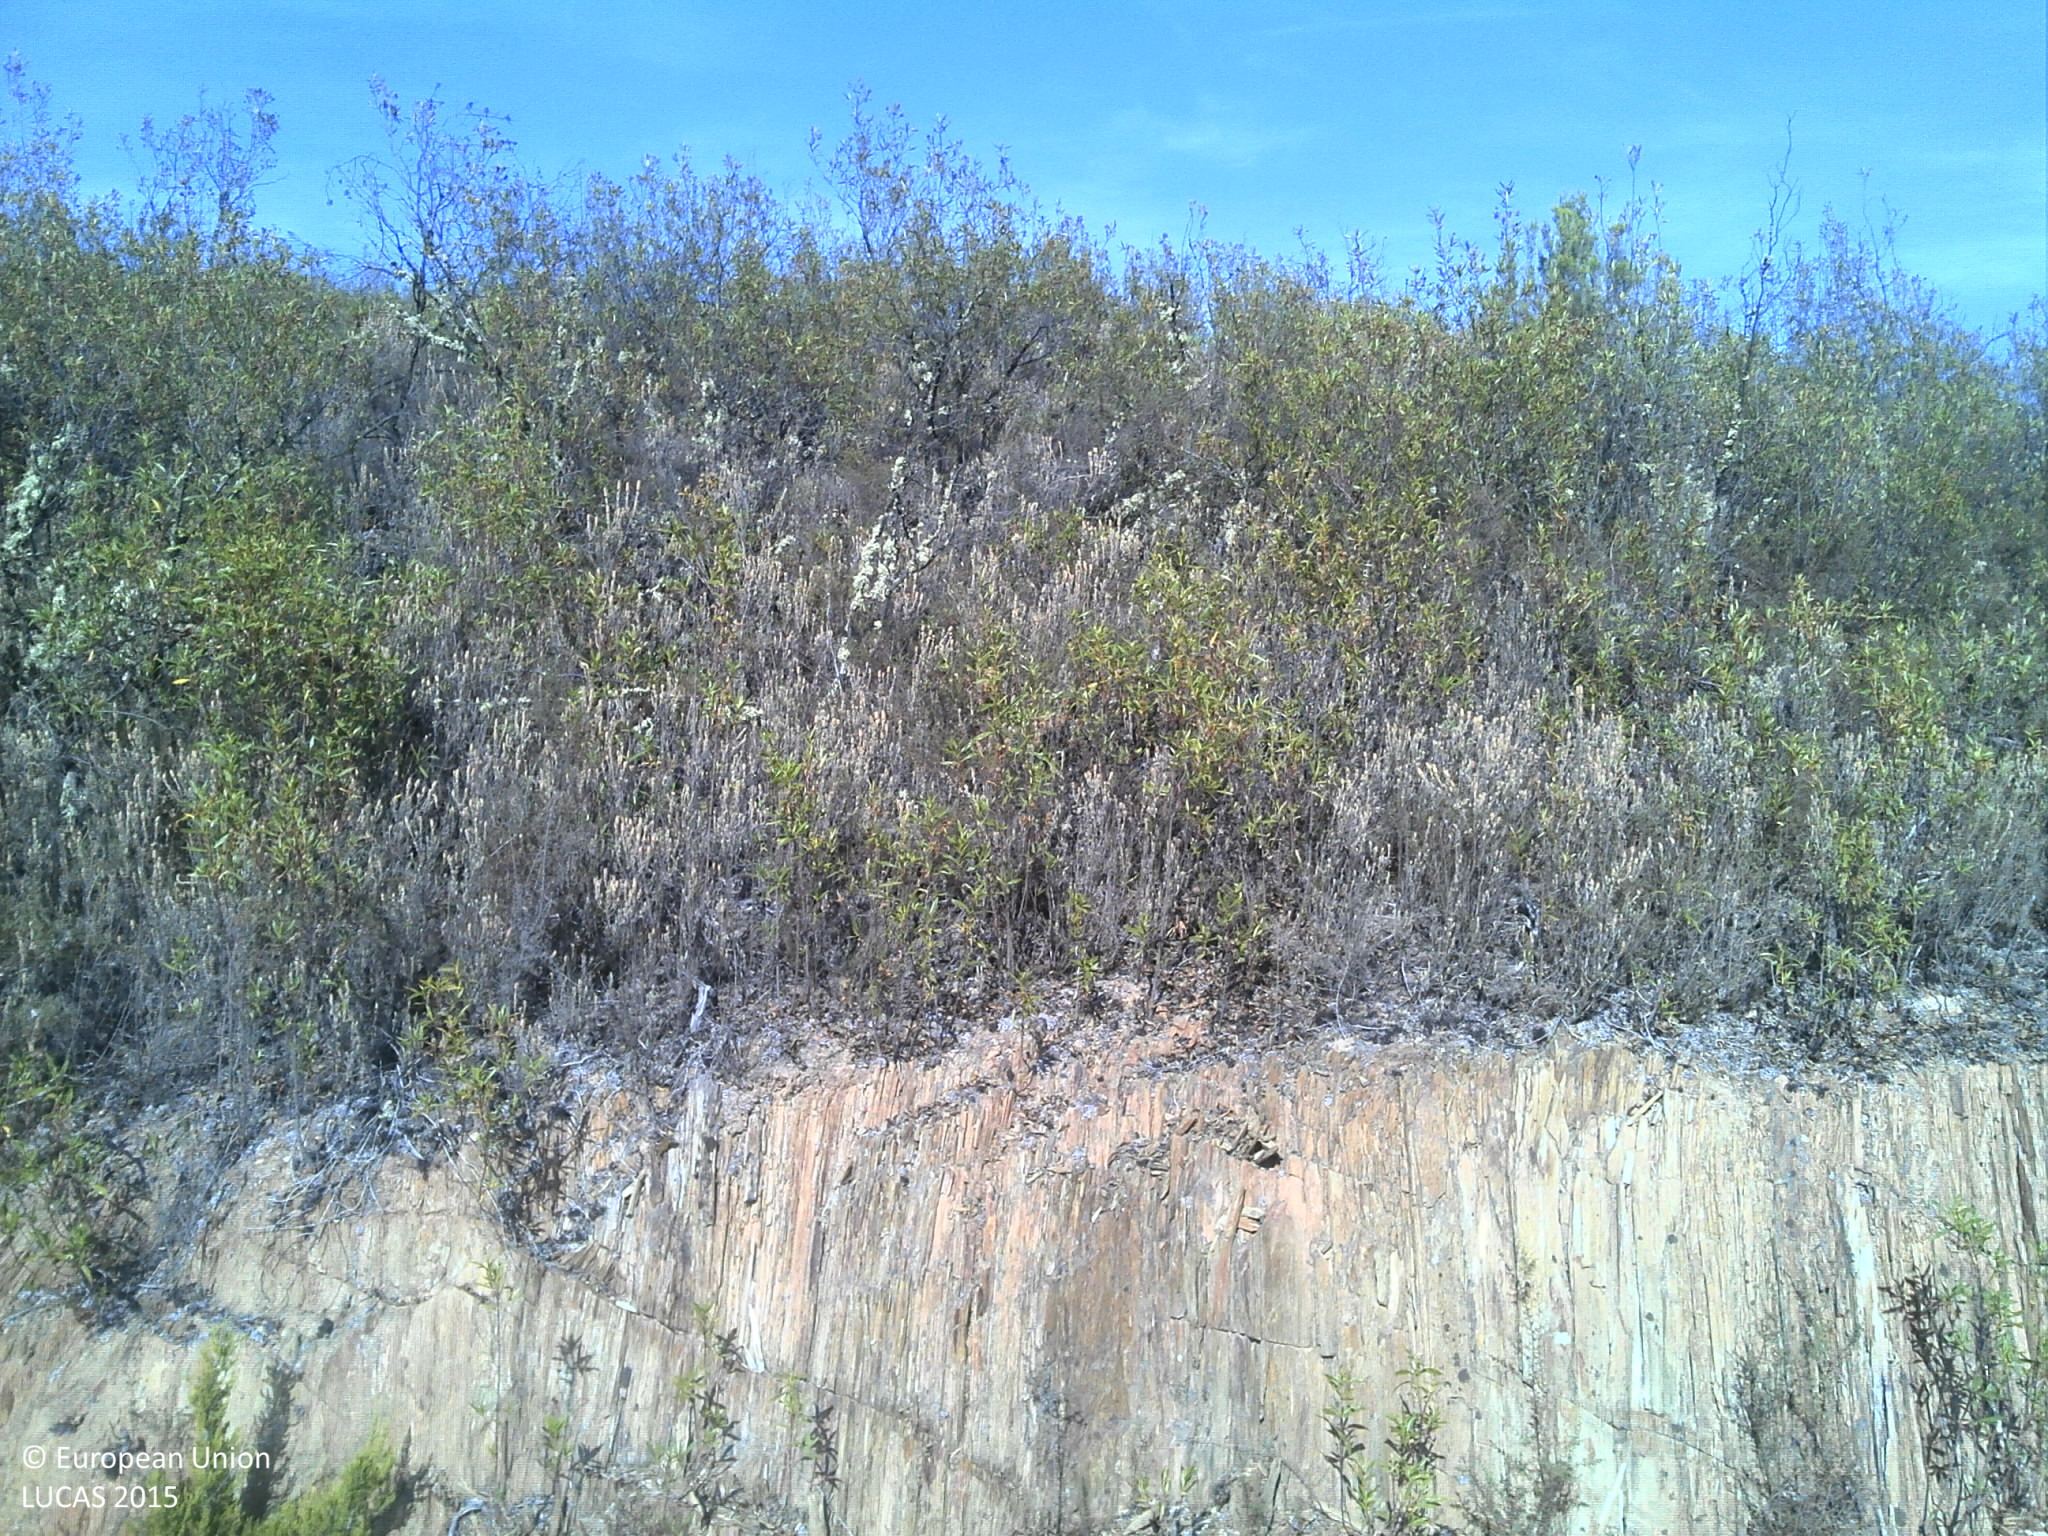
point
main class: Shrubland
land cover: Shrubland without tree cover
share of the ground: > 75 %
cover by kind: shrubs 85 %, unconsolidated bare surface 10 %, herbaceous plants 5 %
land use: Abandoned areas
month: July
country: PT
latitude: 39.6728
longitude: -7.5256
